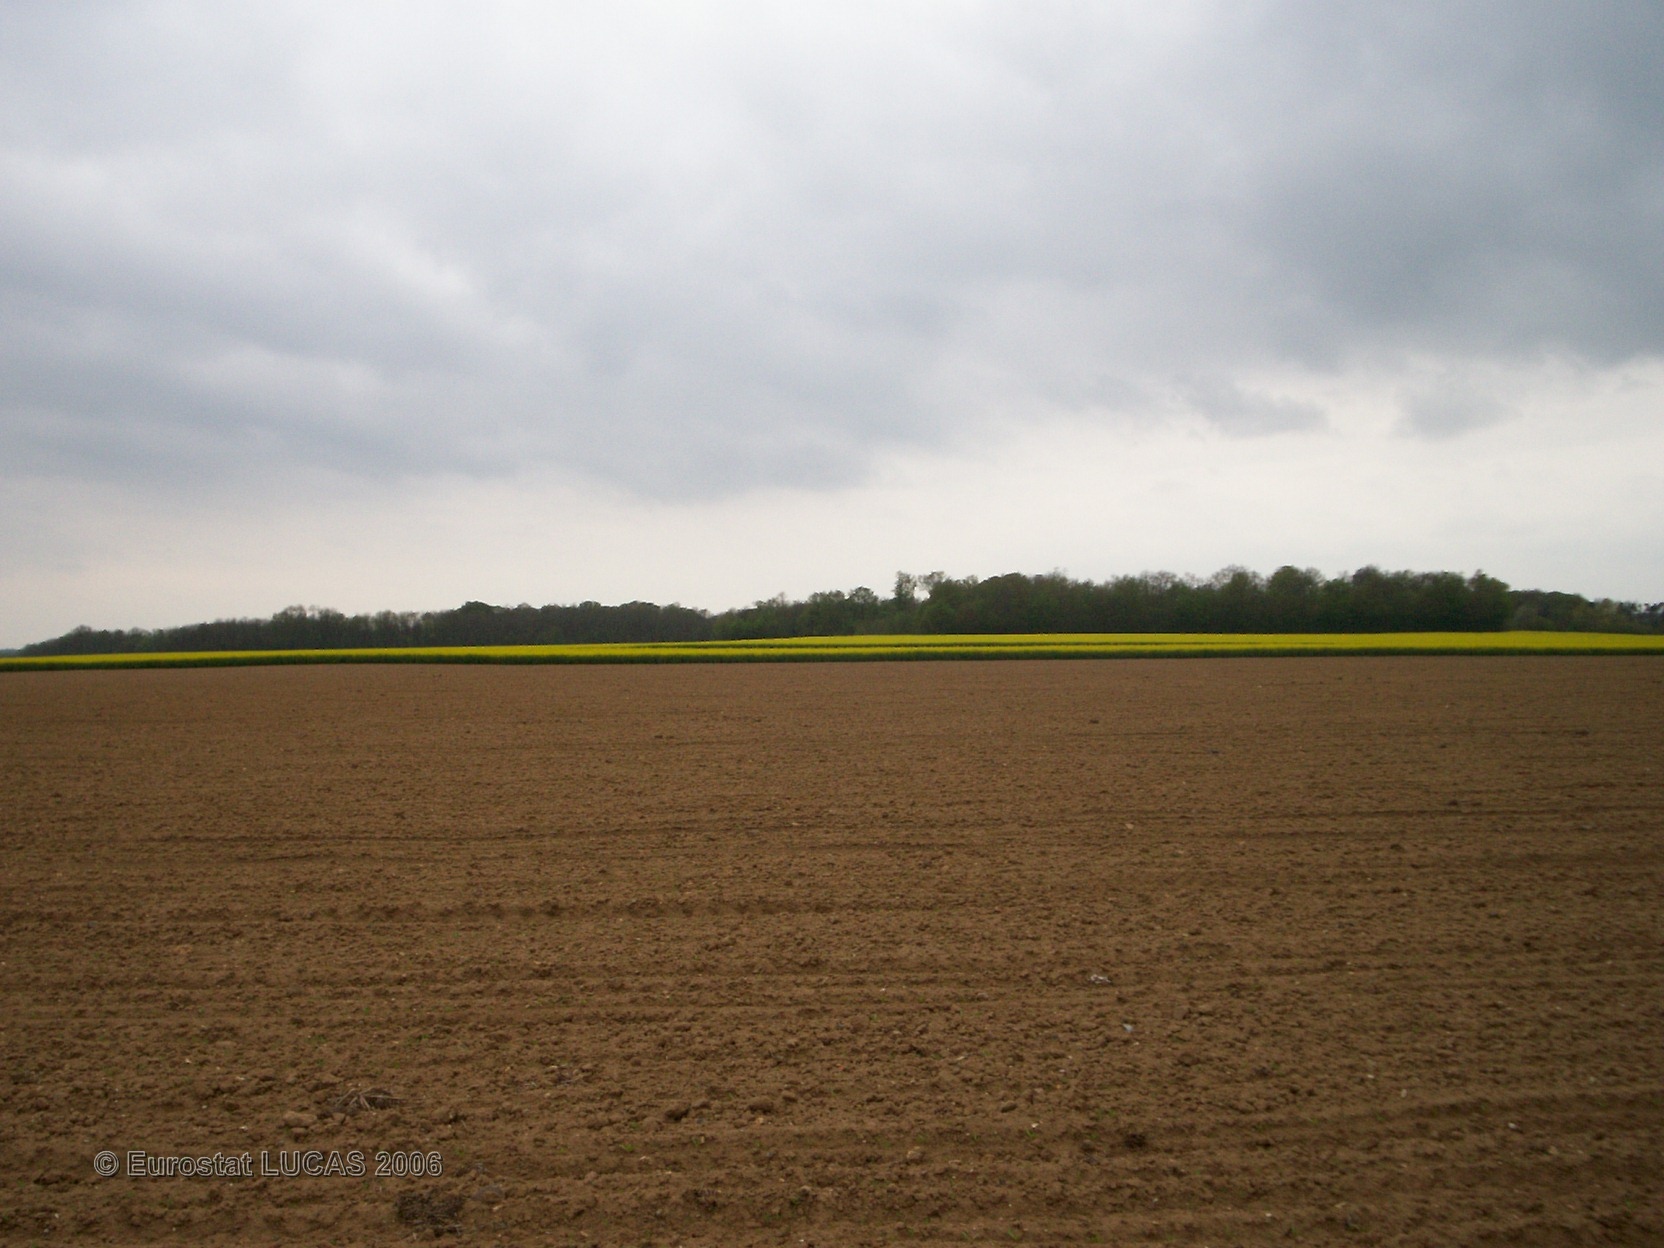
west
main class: Cropland
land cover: Sugar beet
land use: Agriculture (excluding fallow land and kitchen gardens)
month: May
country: FR
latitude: 48.1558
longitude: 2.8807
